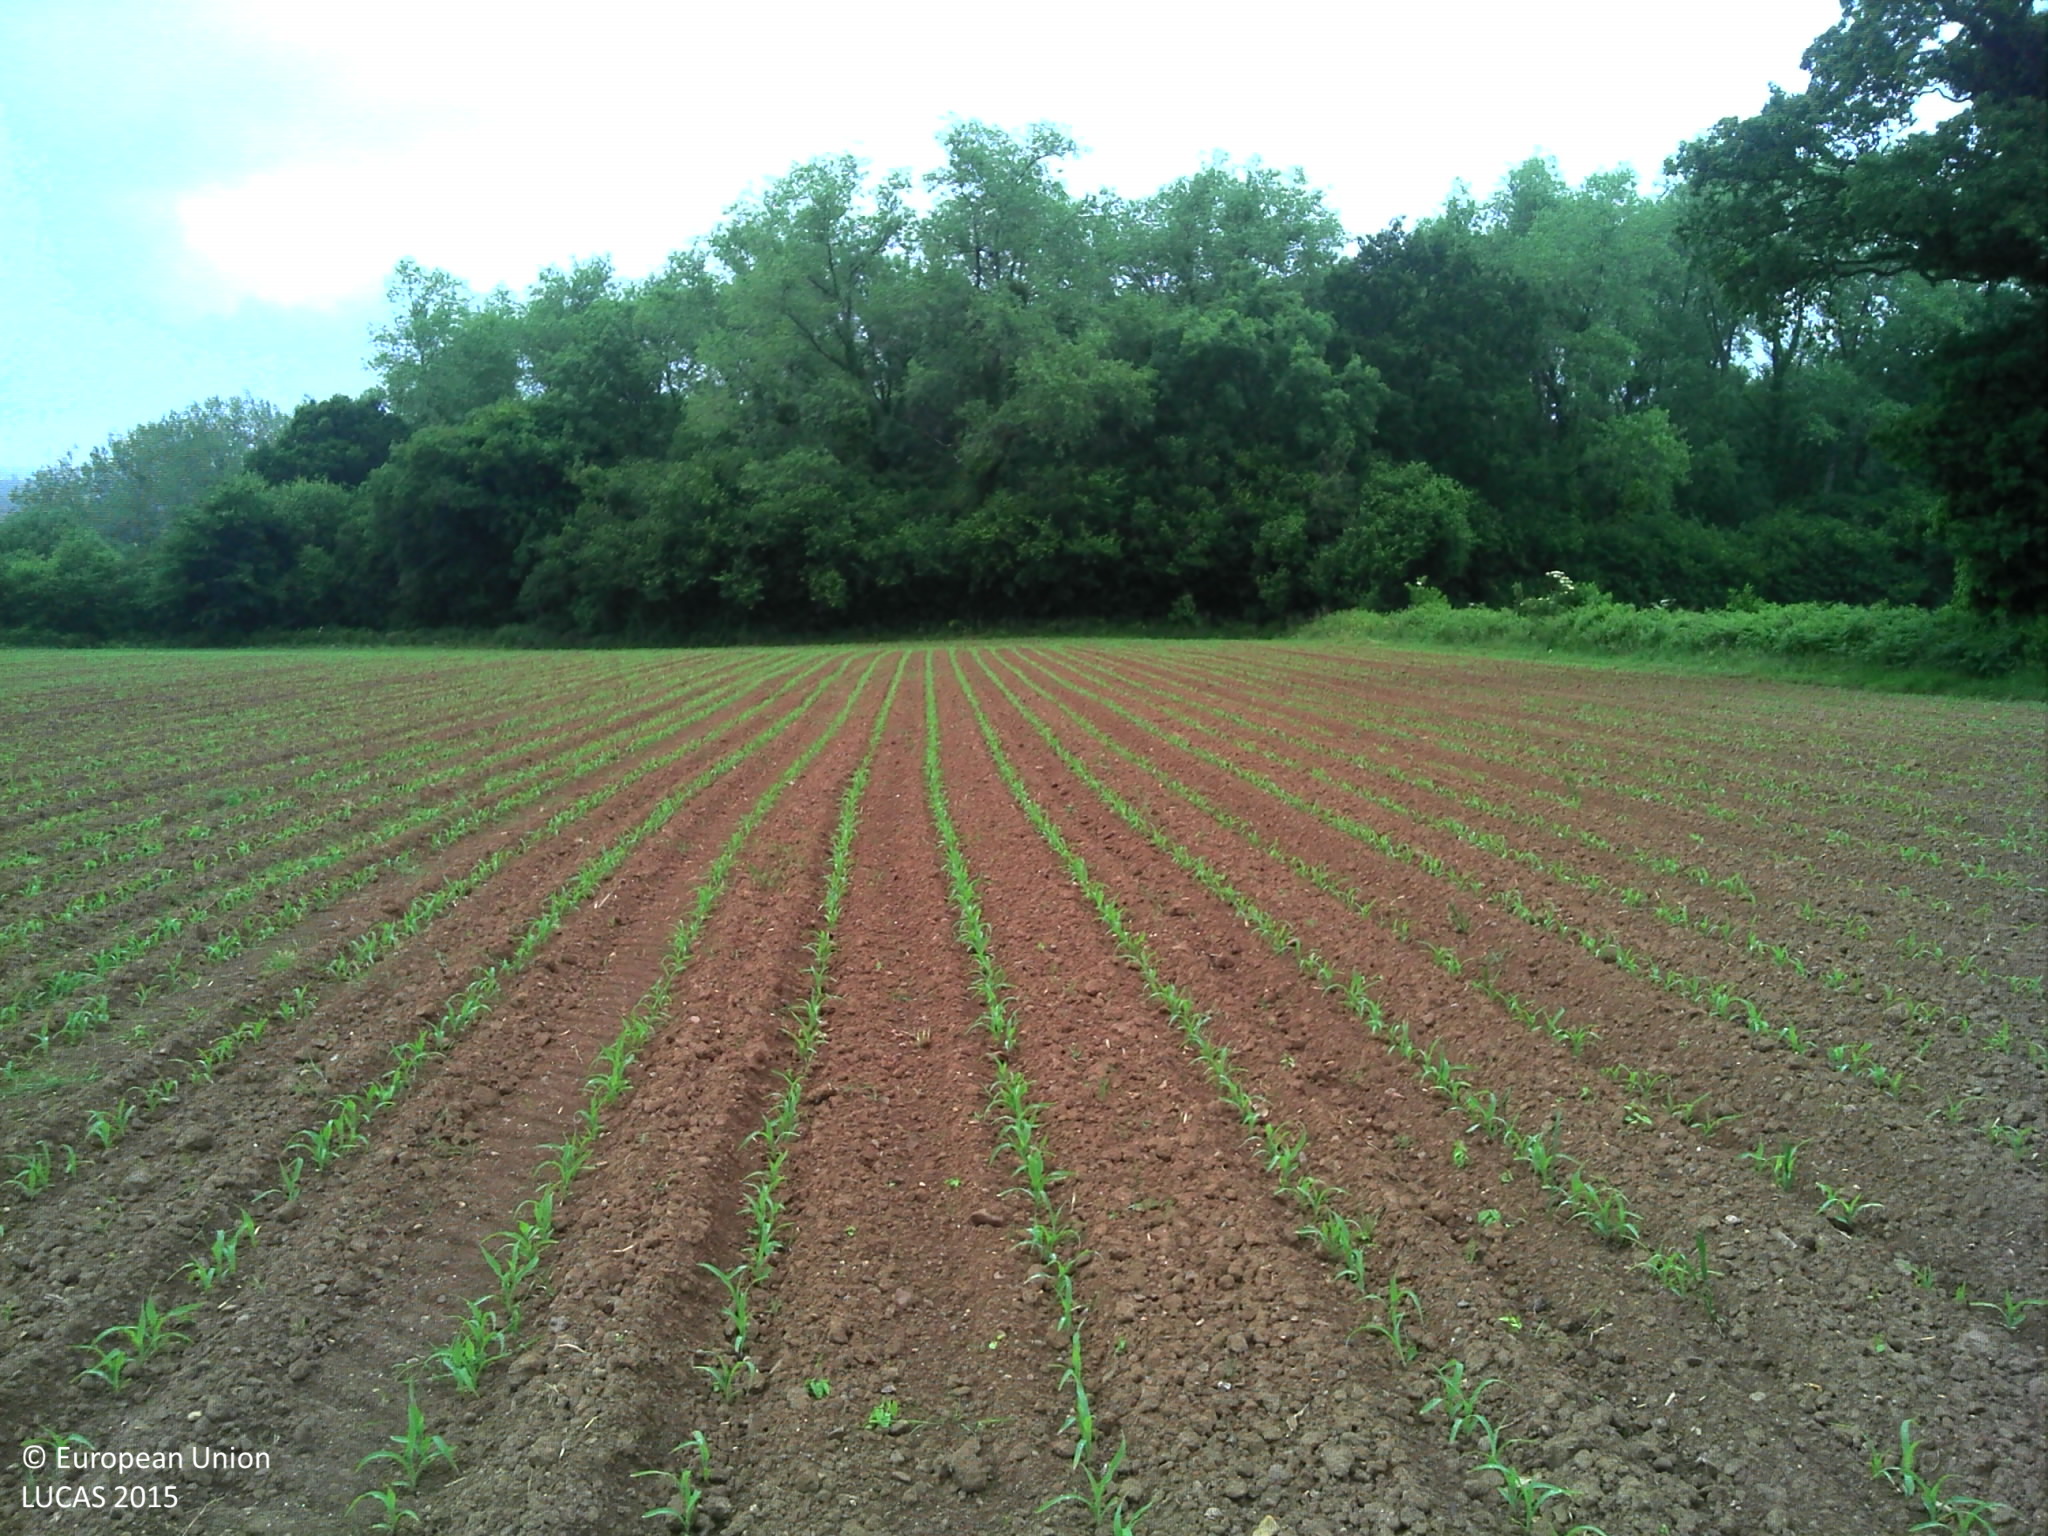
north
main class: Cropland
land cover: Maize
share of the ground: < 10 %
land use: Agriculture (excluding fallow land and kitchen gardens)
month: June
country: FR
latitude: 49.4684
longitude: -1.5446
